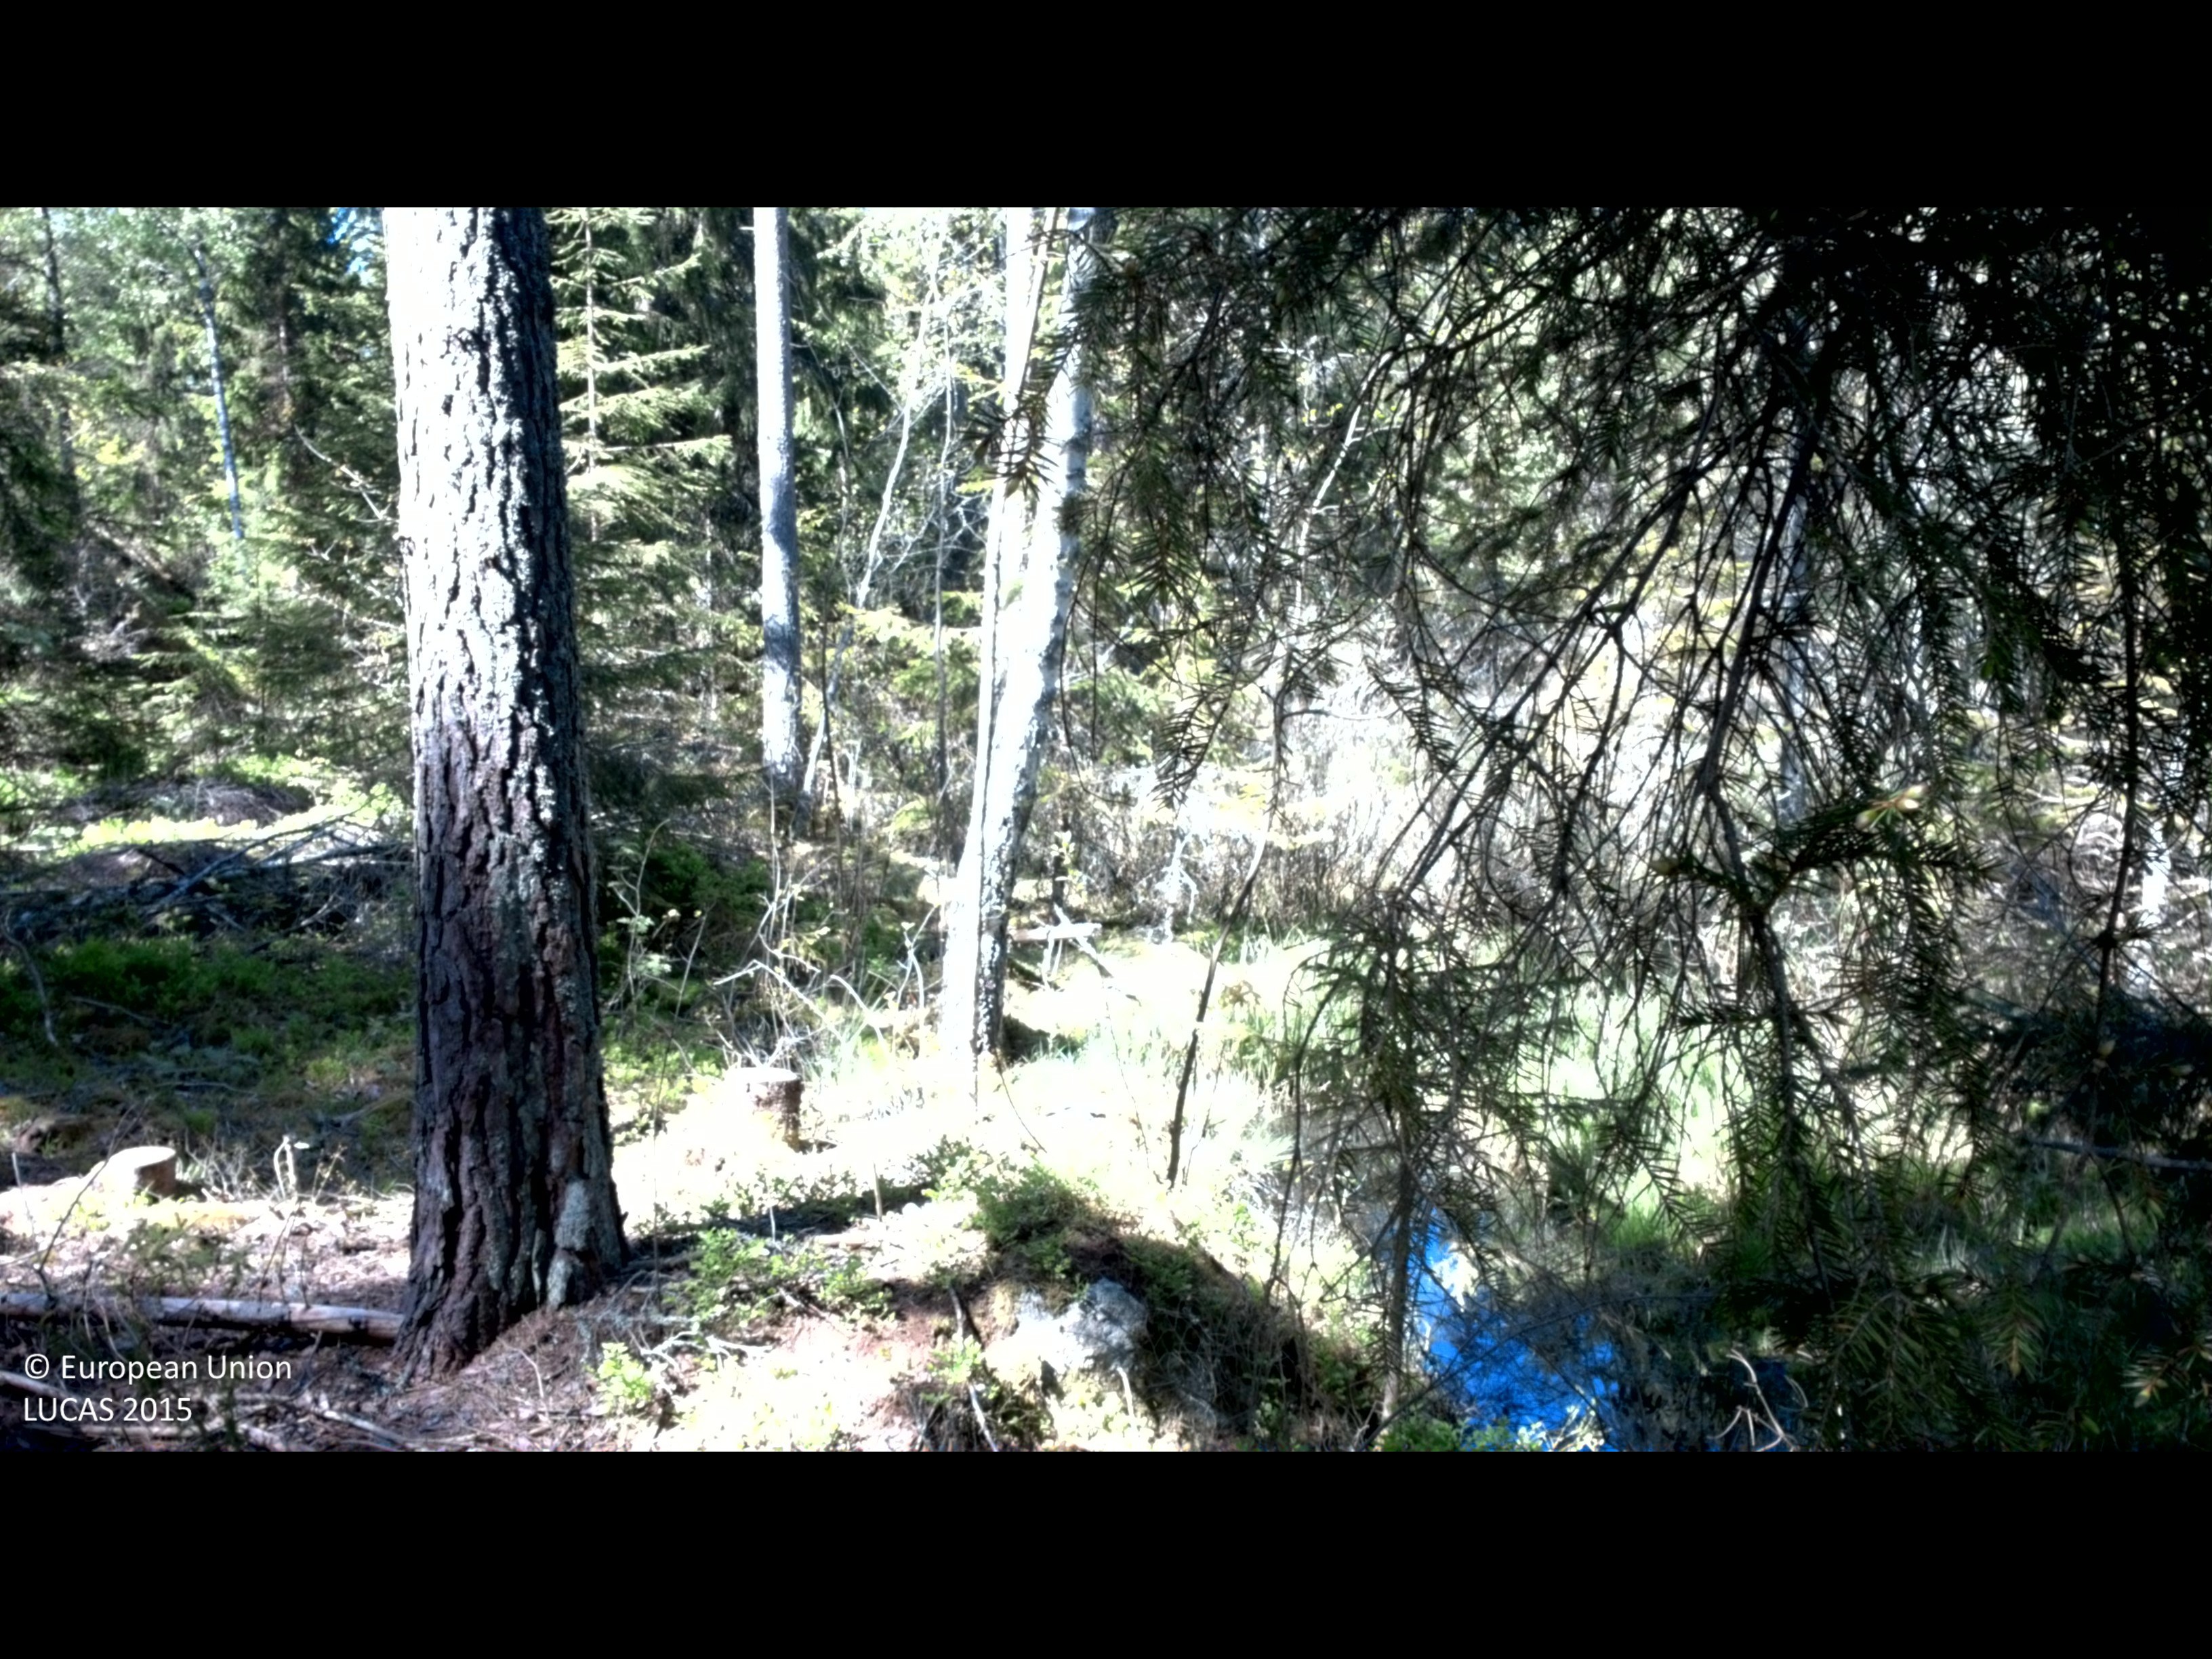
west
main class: Woodland
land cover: Spruce dominated mixed woodland
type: boreal forest
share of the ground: > 75 %
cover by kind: coniferous forest trees 65 %, broadleaved forest trees 25 %, shrubs 5 %, herbaceous plants 5 %
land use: Forestry
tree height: > 5 m
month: May
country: SE
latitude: 57.2832
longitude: 16.1865
